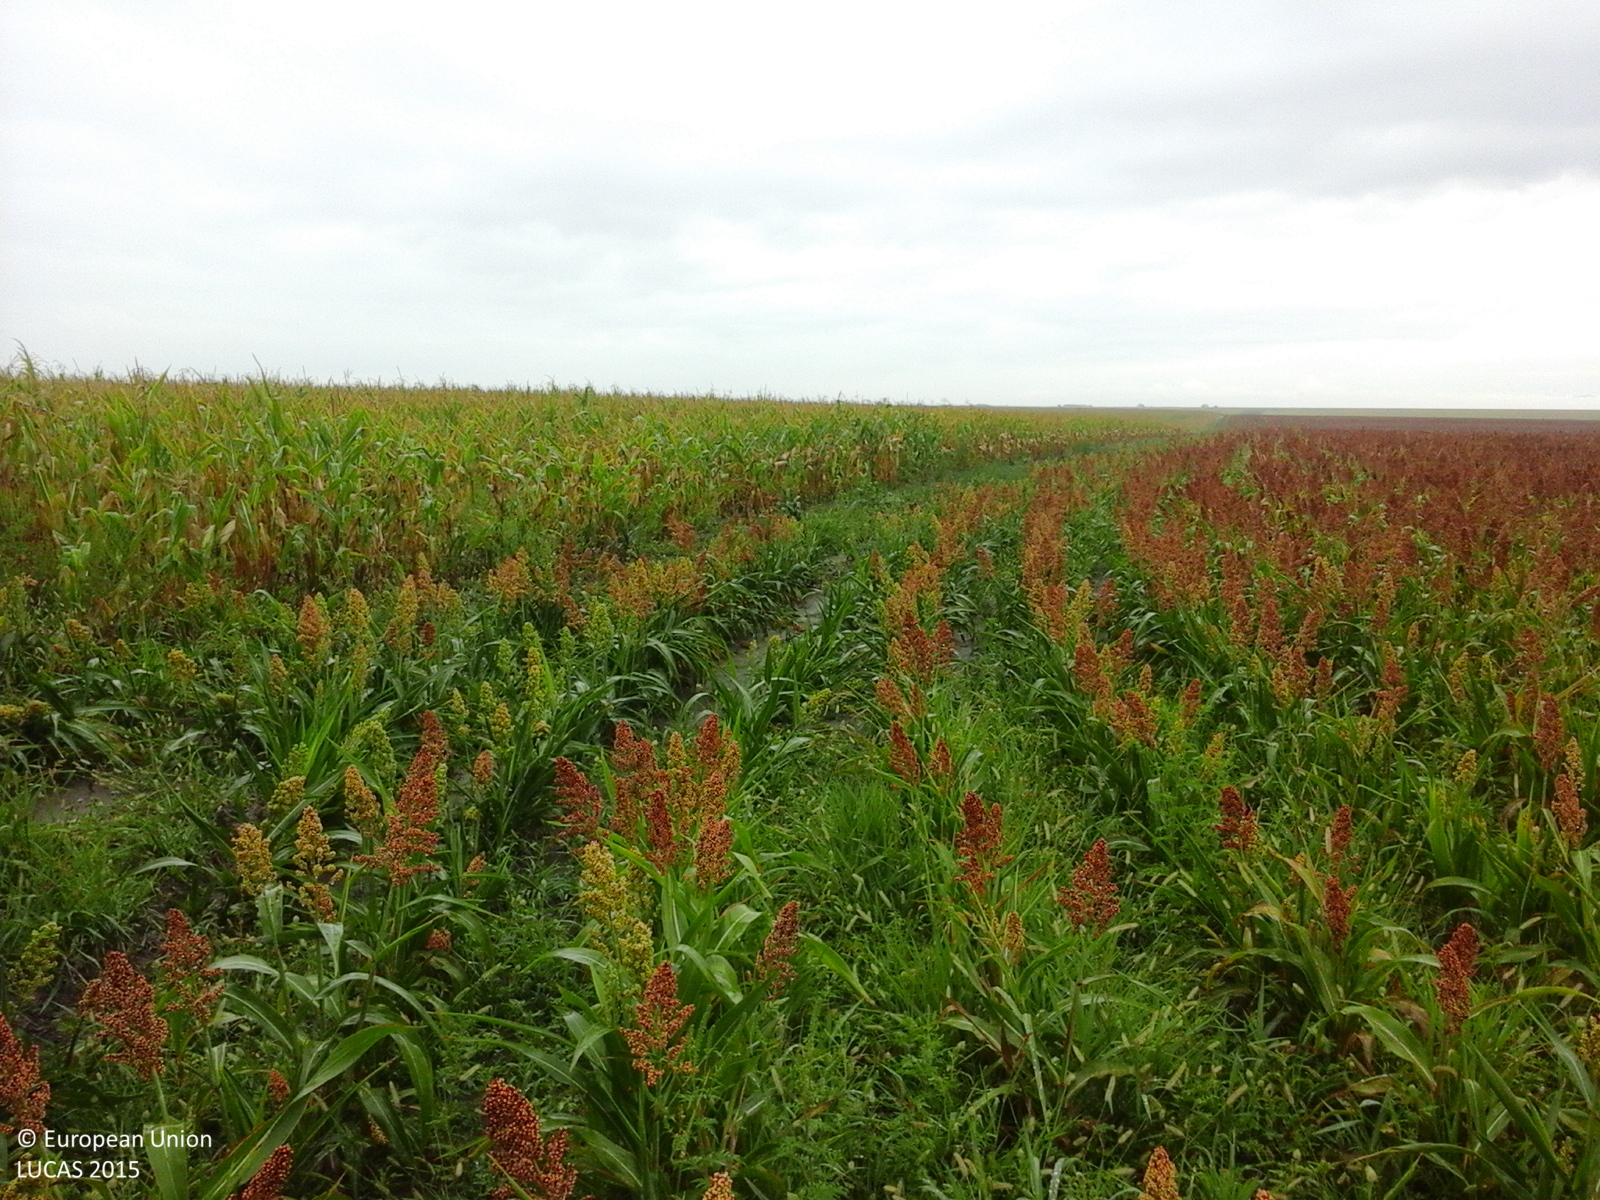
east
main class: Cropland
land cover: Other cereals
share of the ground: > 75 %
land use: Agriculture (excluding fallow land and kitchen gardens)
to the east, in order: Other cereals
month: August
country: RO
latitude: 45.4762
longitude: 21.4810
